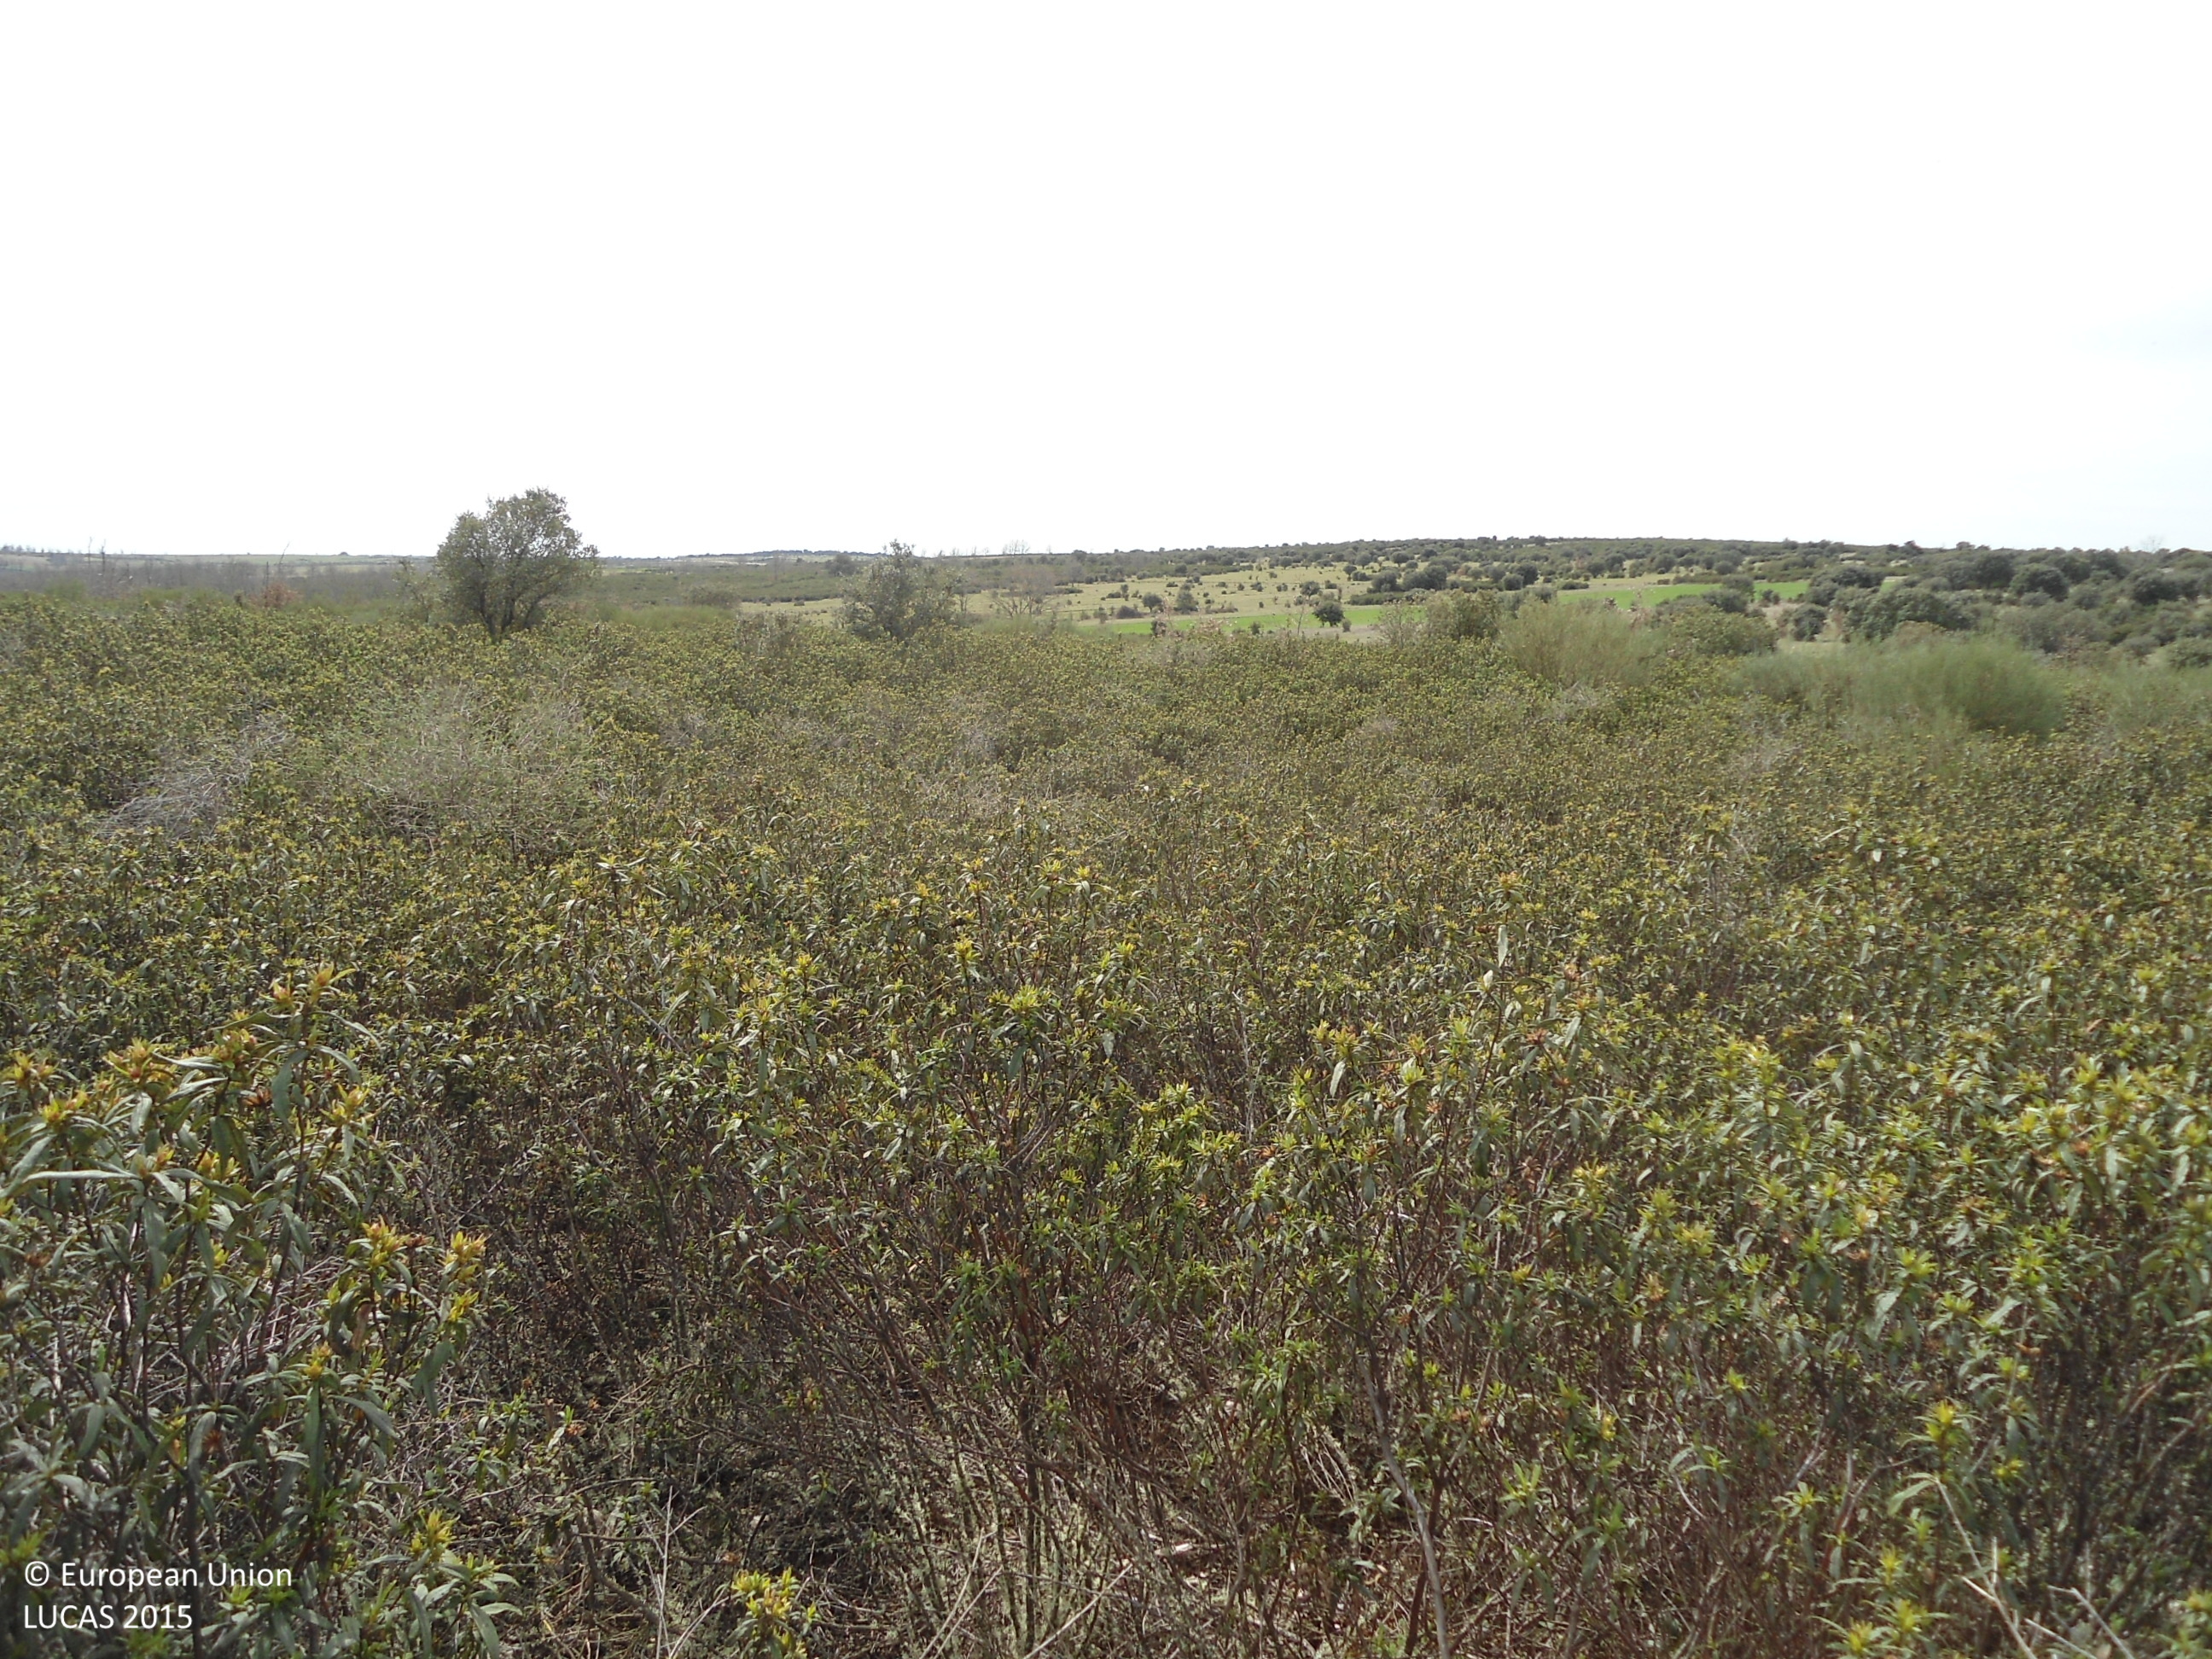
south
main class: Shrubland
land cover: Shrubland with sparse tree cover
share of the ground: > 75 %
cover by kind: shrubs 95 %, broadleaved forest trees 5 %
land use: Semi-natural and natural areas not in use
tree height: < 5 m
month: April
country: ES
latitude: 41.6285
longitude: -6.1204
